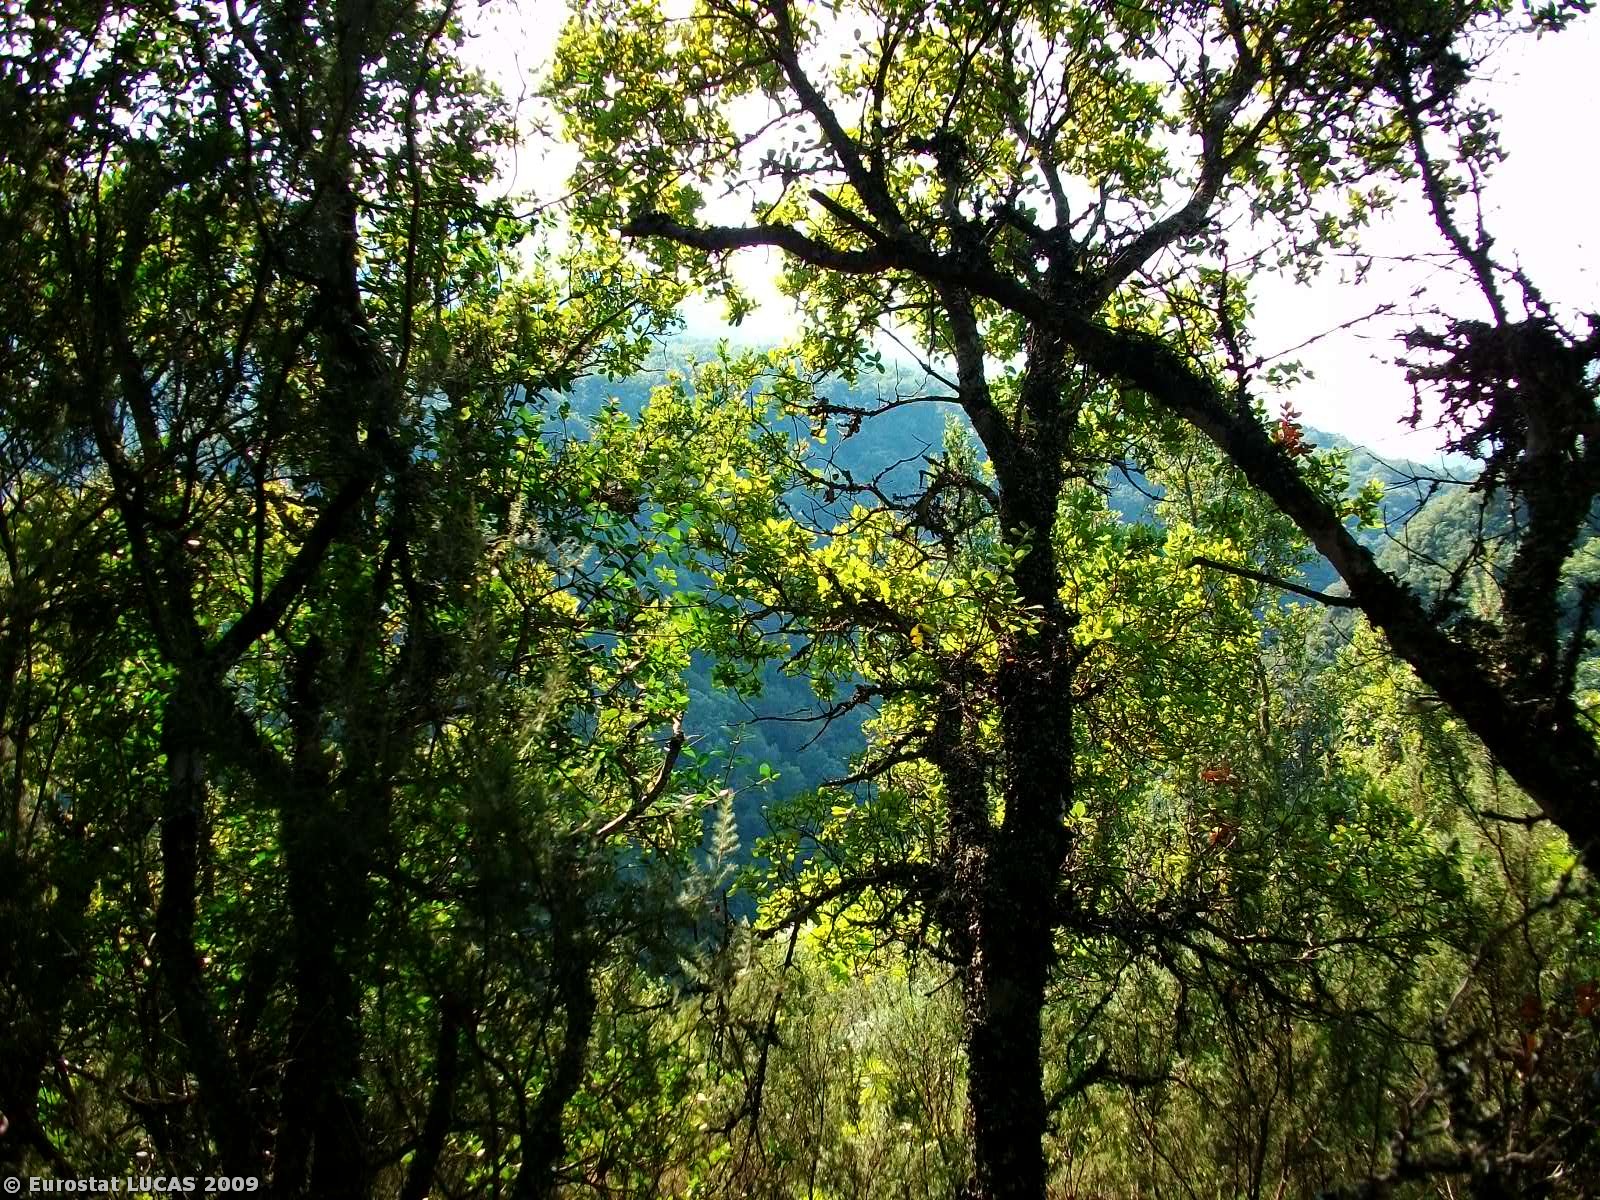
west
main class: Woodland
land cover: Mixed woodland
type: mesophytic deciduous forest
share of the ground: > 75 %
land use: Forestry
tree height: > 5 m
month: August
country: GR
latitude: 39.6501
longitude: 20.4766
